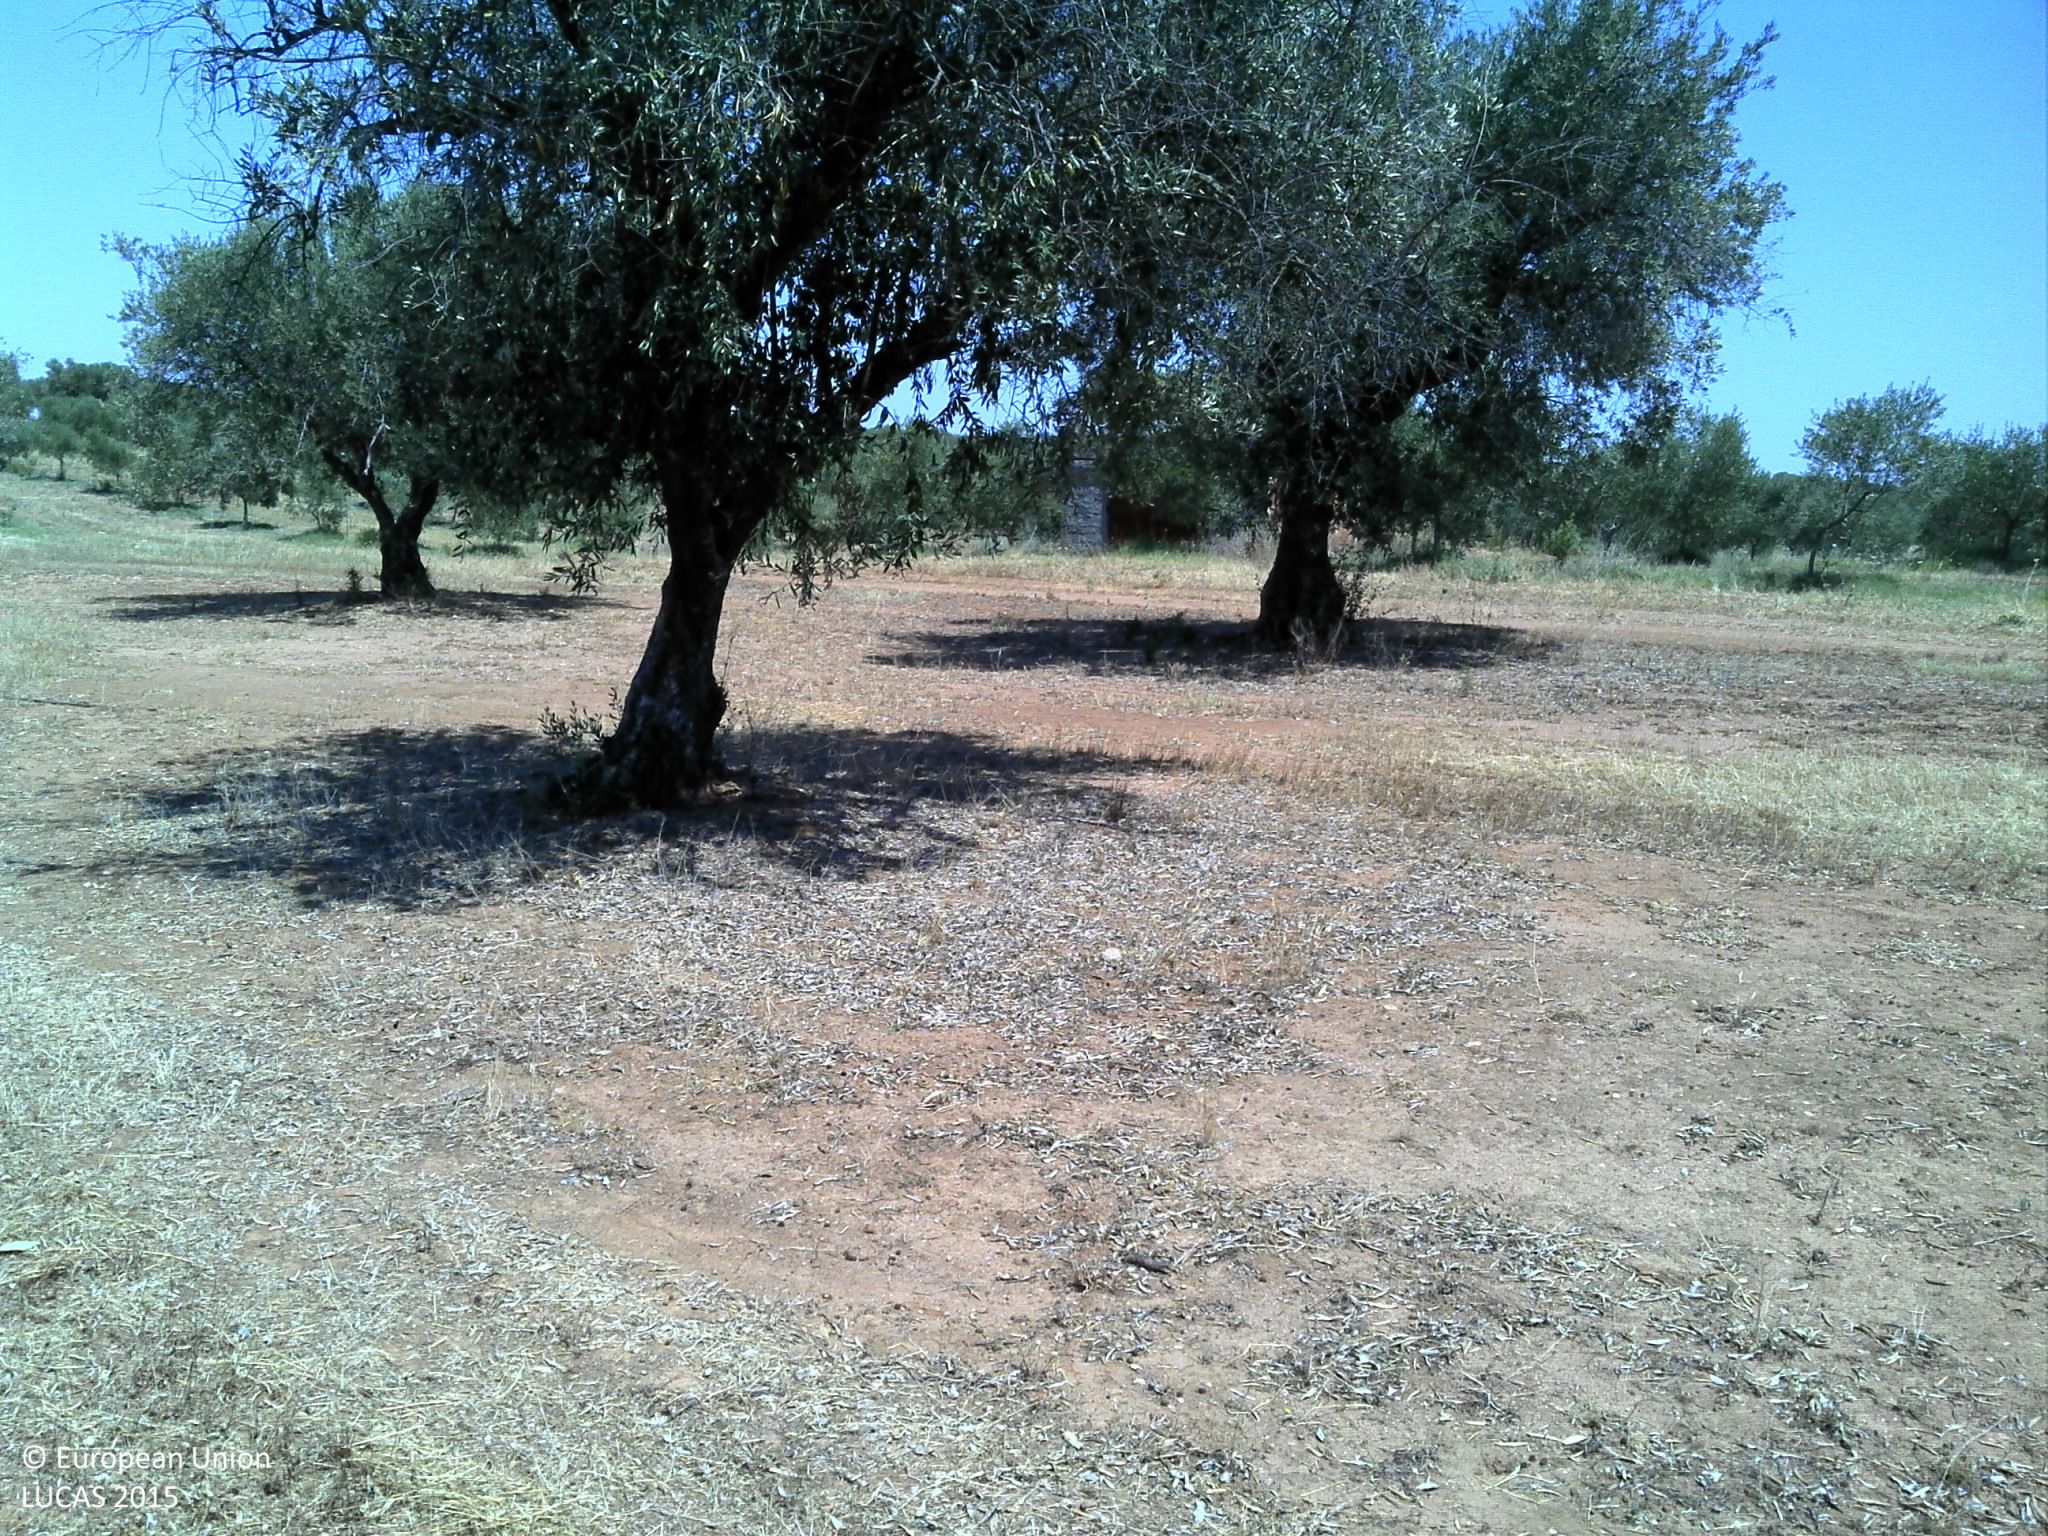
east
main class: Cropland
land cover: Olive groves
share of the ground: 25 - 50 %
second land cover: Grassland without tree/shrub cover
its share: 10 - 25 %
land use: Agriculture (excluding fallow land and kitchen gardens)
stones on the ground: < 10 %
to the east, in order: Olive groves; Grassland without tree/shrub cover; Olive groves; Tracks; Olive groves; Tracks
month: June
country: PT
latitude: 38.0419
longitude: -7.5573
